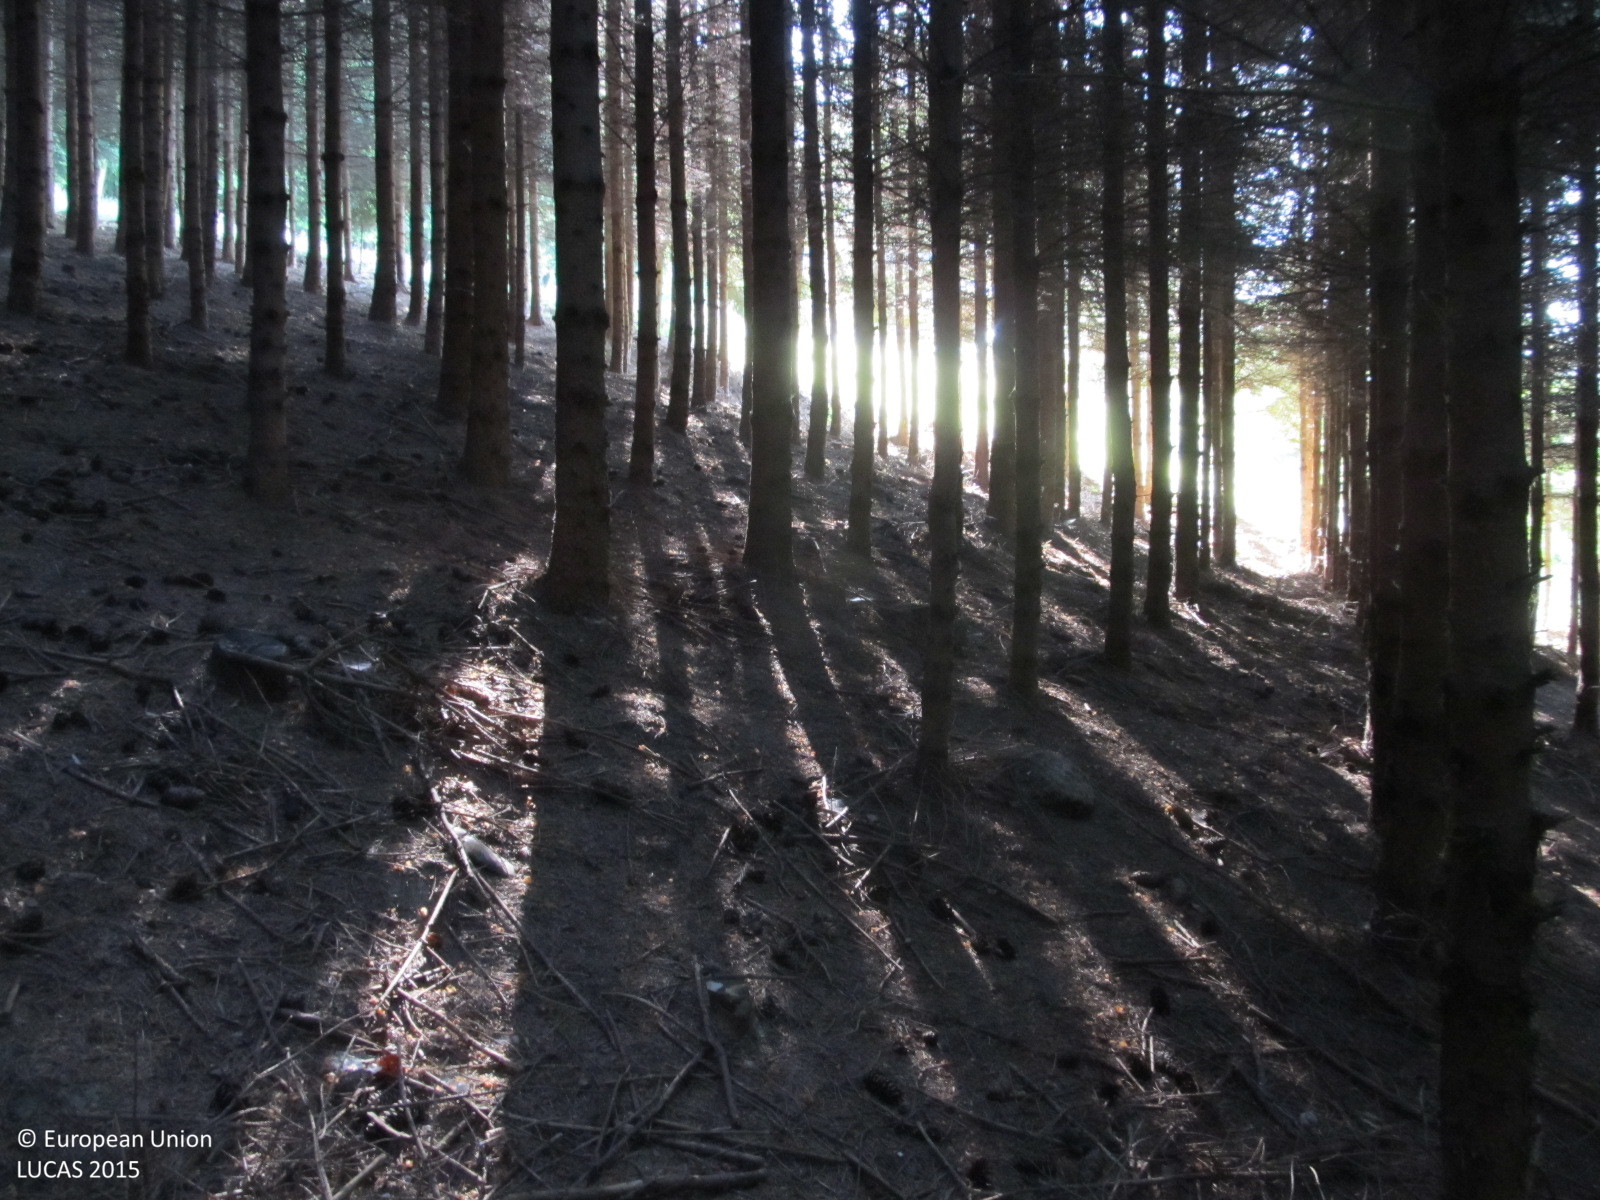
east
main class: Woodland
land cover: Spruce dominated coniferous woodland
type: hemiboreal forest and nemoral coniferous forest and mixed broadleaved-coniferous forest
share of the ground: > 75 %
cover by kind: coniferous forest trees 85 %, unconsolidated bare surface 15 %
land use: Forestry
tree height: > 5 m
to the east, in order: Spruce dominated coniferous woodland; Grassland without tree/shrub cover; Other mixed woodland; Grassland without tree/shrub cover; Shrubland with sparse tree cover; Grassland without tree/shrub cover
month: June
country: AT
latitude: 48.5417
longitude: 15.4070
